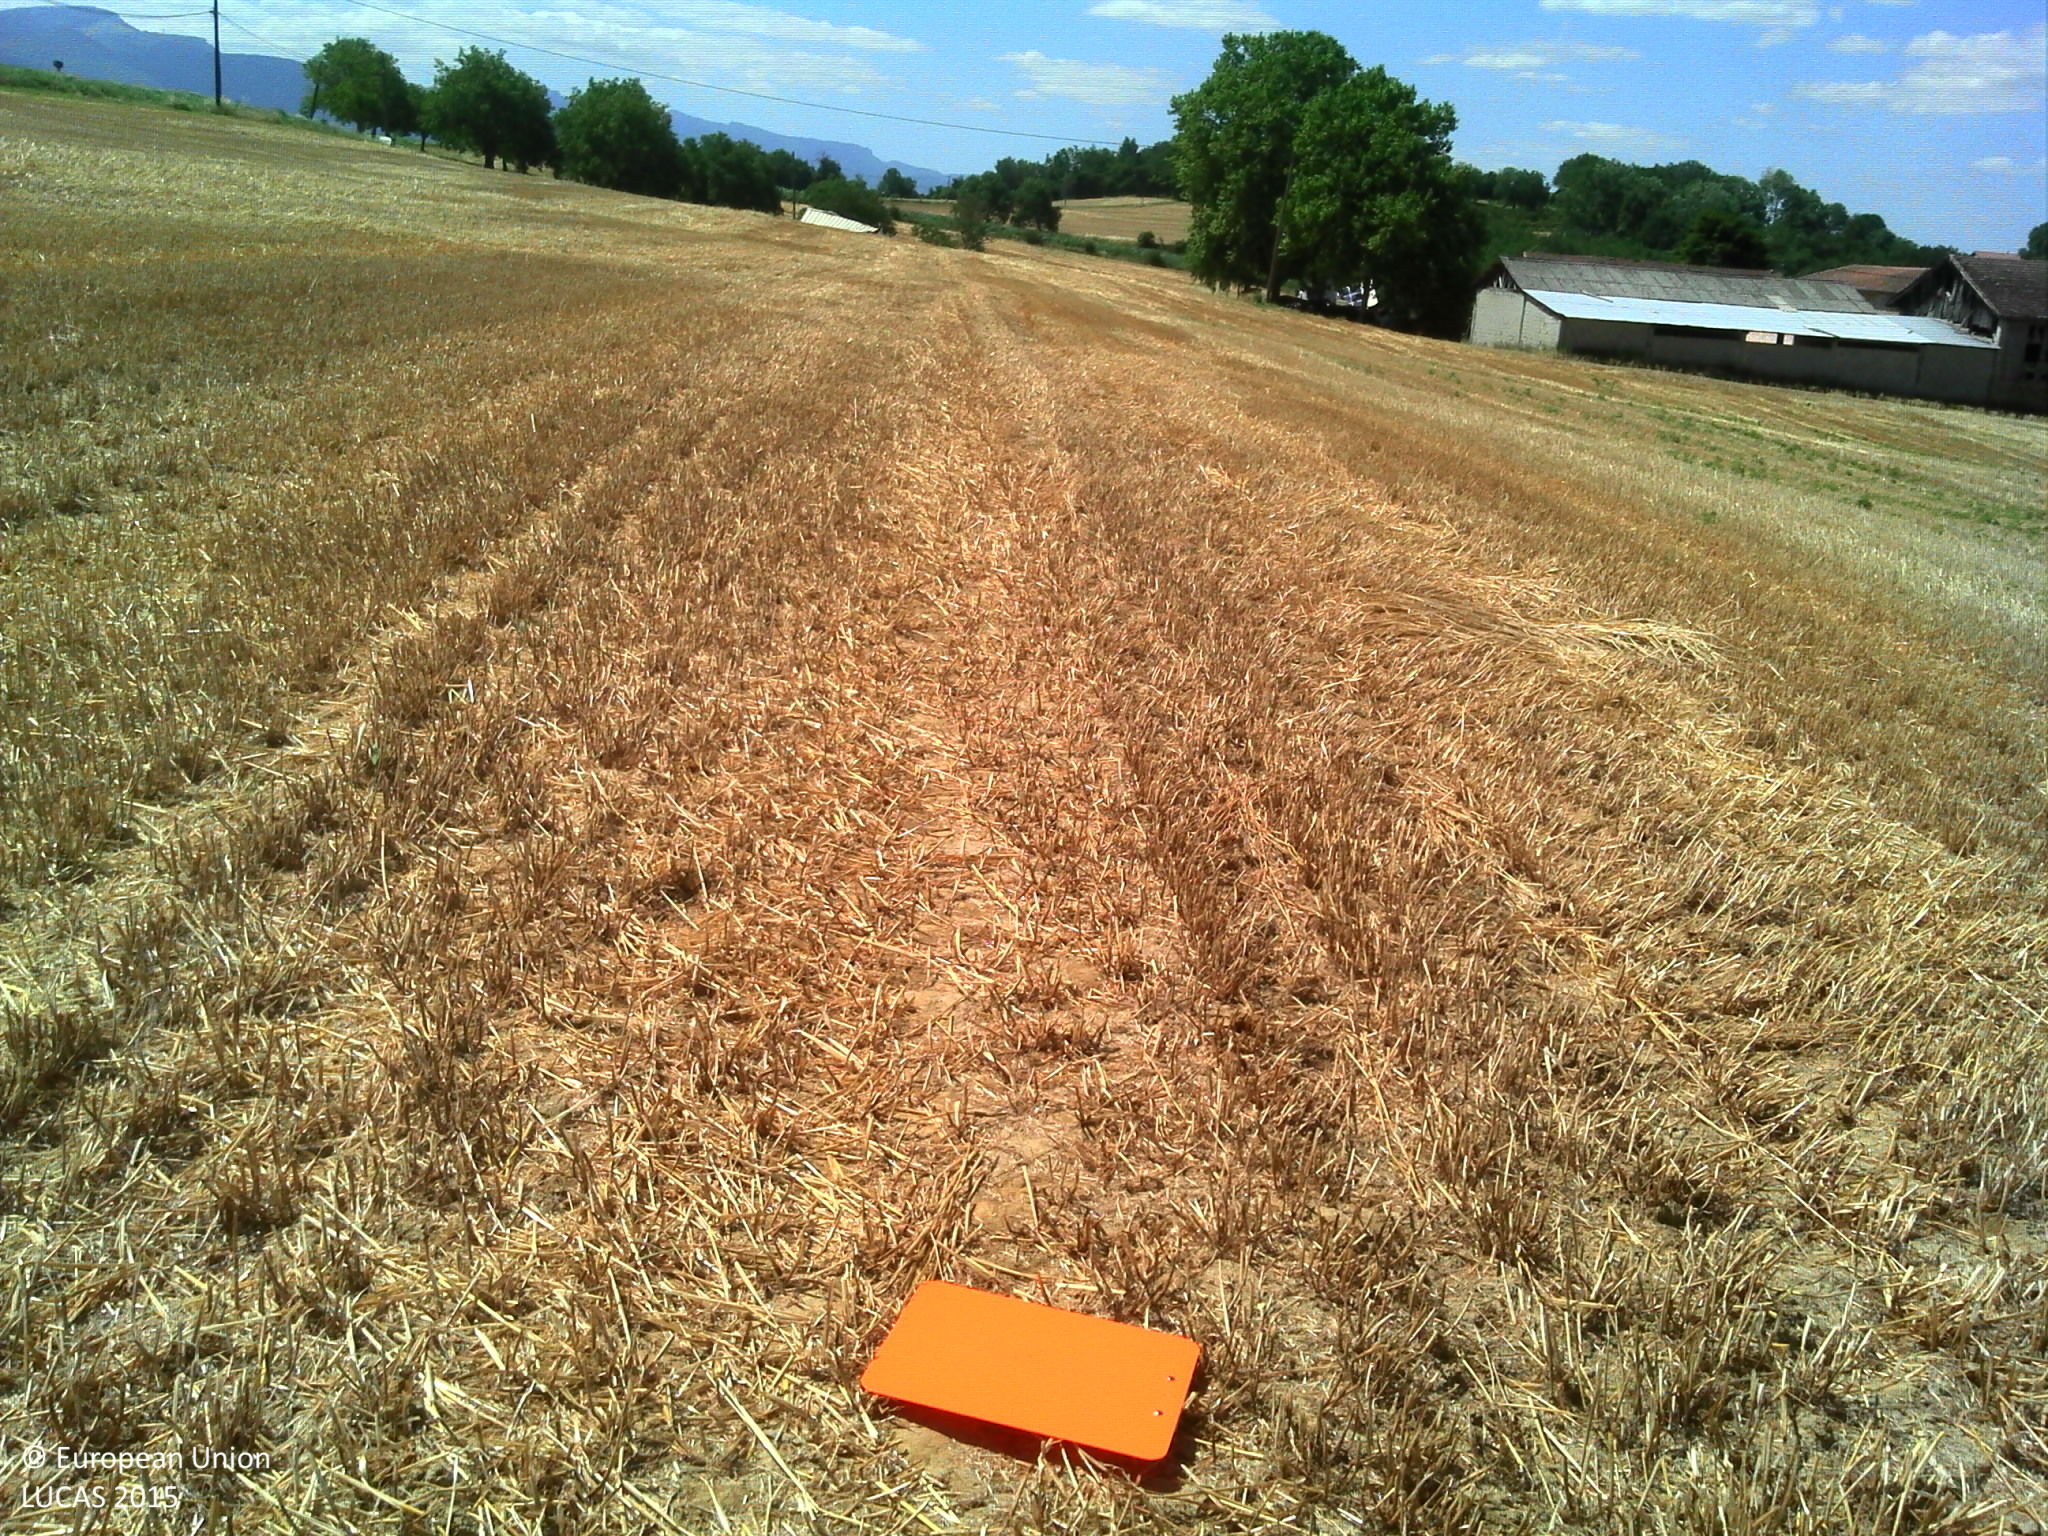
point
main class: Cropland
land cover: Barley
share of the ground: > 75 %
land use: Agriculture (excluding fallow land and kitchen gardens)
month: July
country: FR
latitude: 45.1239
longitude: 5.1871
